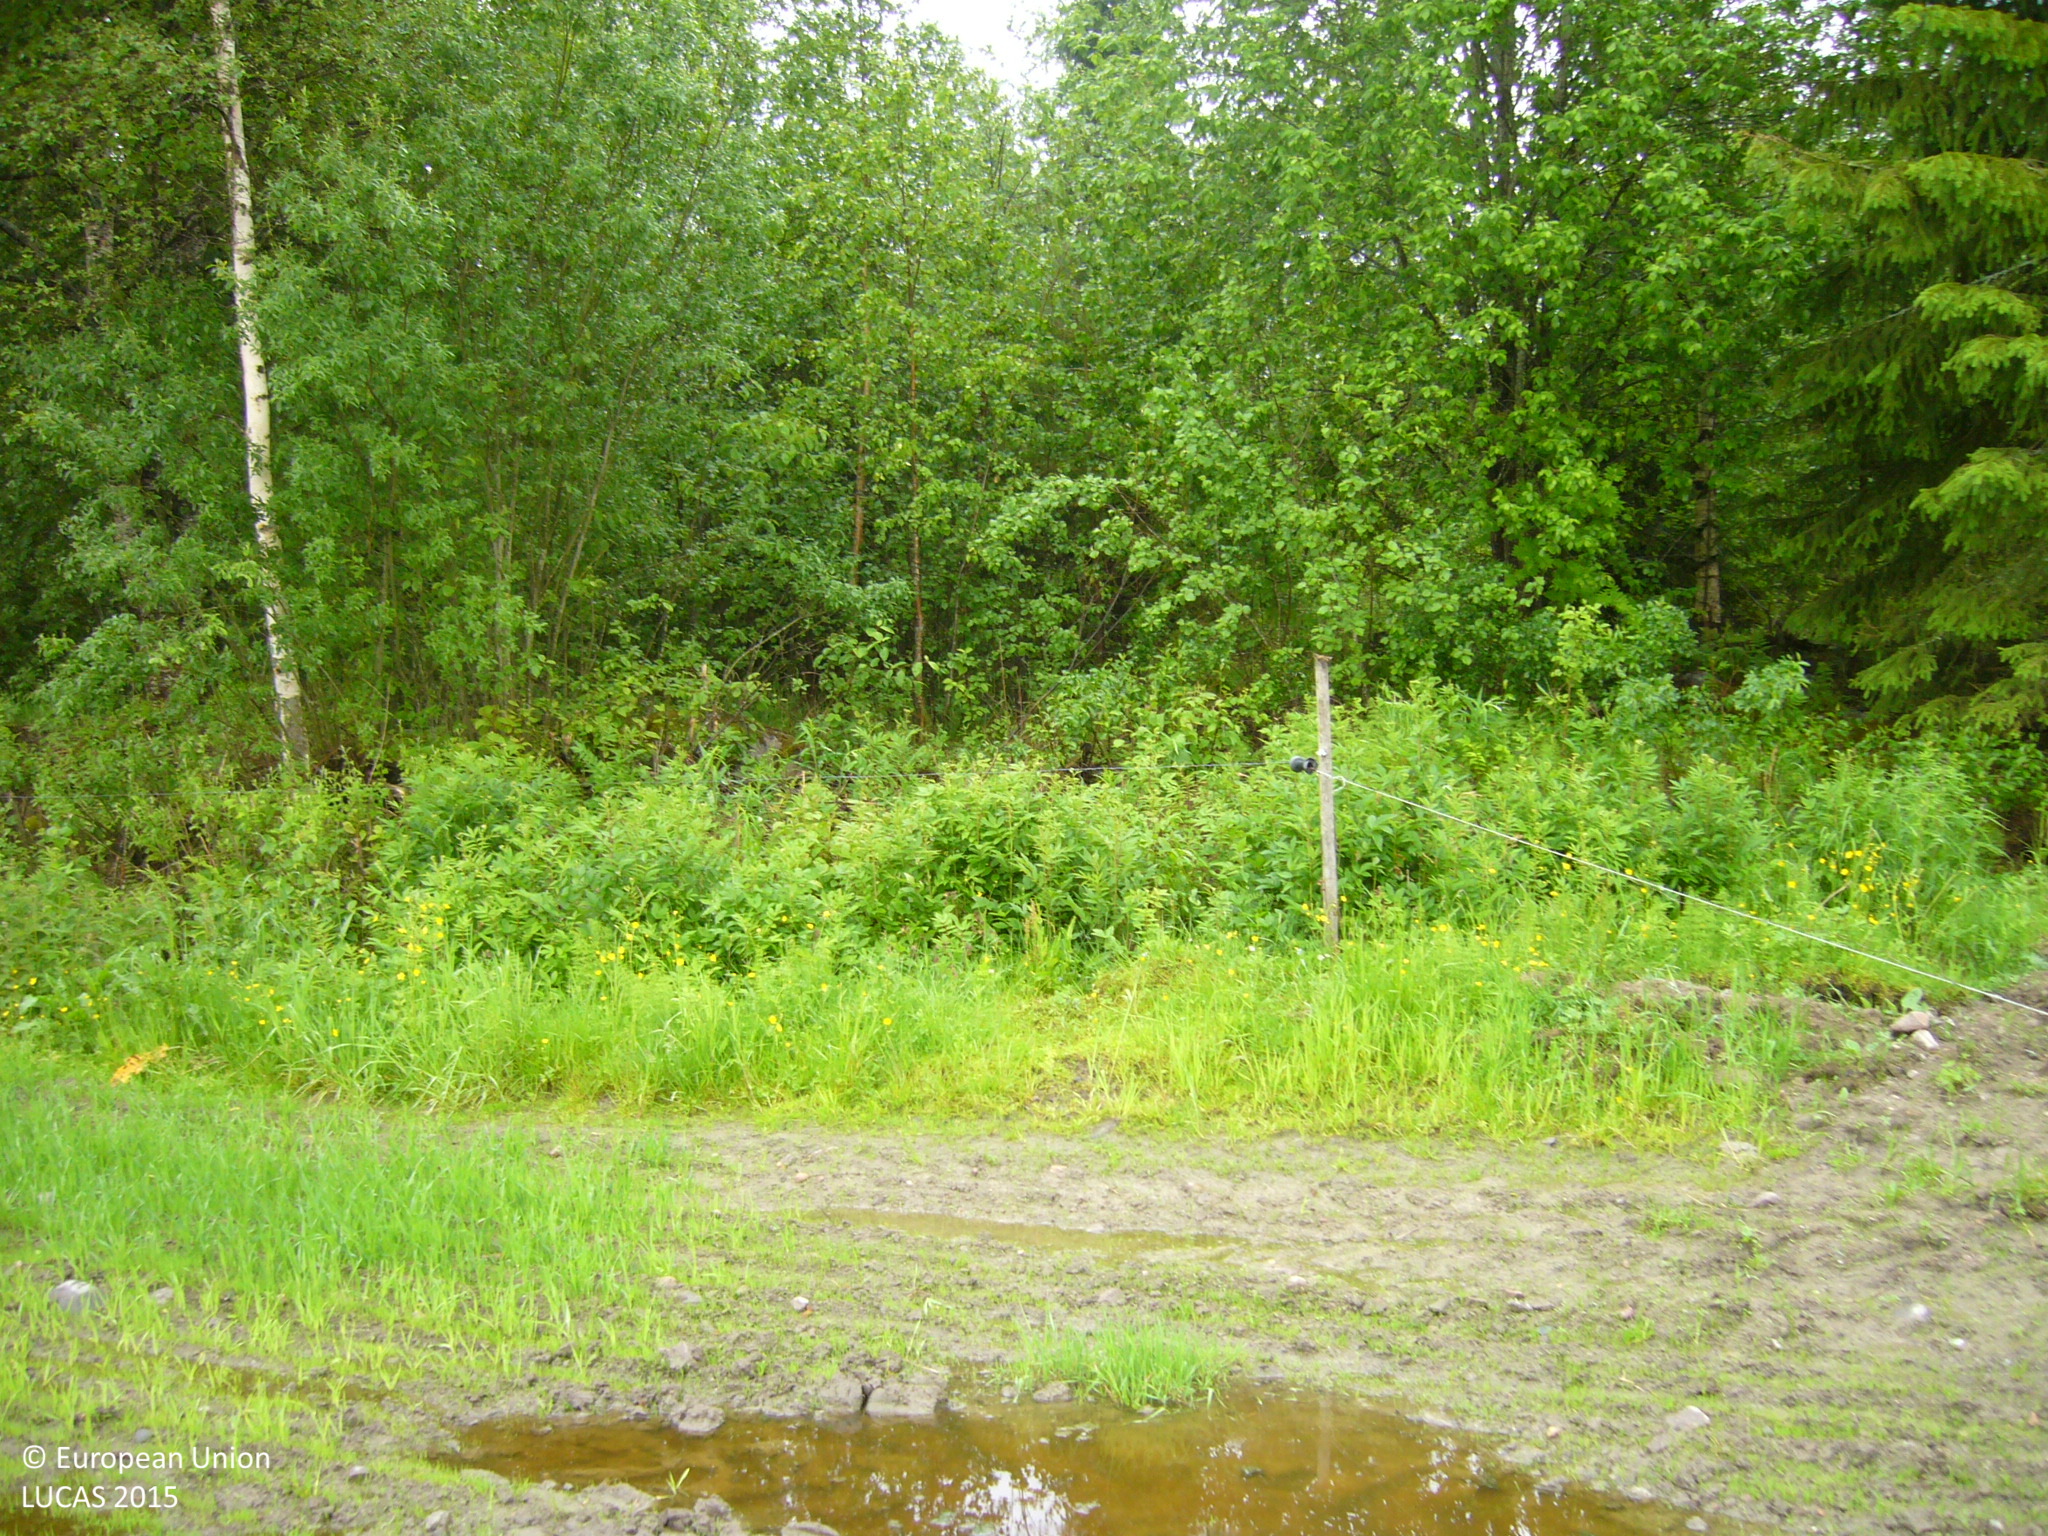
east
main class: Grassland
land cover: Grassland without tree/shrub cover
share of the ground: > 75 %
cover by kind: herbaceous plants 80 %, unconsolidated bare surface 20 %
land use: Agriculture (excluding fallow land and kitchen gardens)
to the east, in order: Grassland without tree/shrub cover; Fences; Other mixed woodland; Tracks; Other mixed woodland; Shruby margins; Fences; Paved roads, cycling and walking lanes; Fences; Grassland without tree/shrub cover; Artificial constructions in urban areas; Other mixed woodland; Electric lines; Other mixed woodland; Shruby margins; Ditches and canals; Grass margins; Paved roads, cycling and walking lanes; Grass margins; Ditches and canals; Shruby margins; Fences; Pine dominated coniferous woodland; Fences; Temporary grasslands
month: June
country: FI
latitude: 63.6236
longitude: 26.4453
